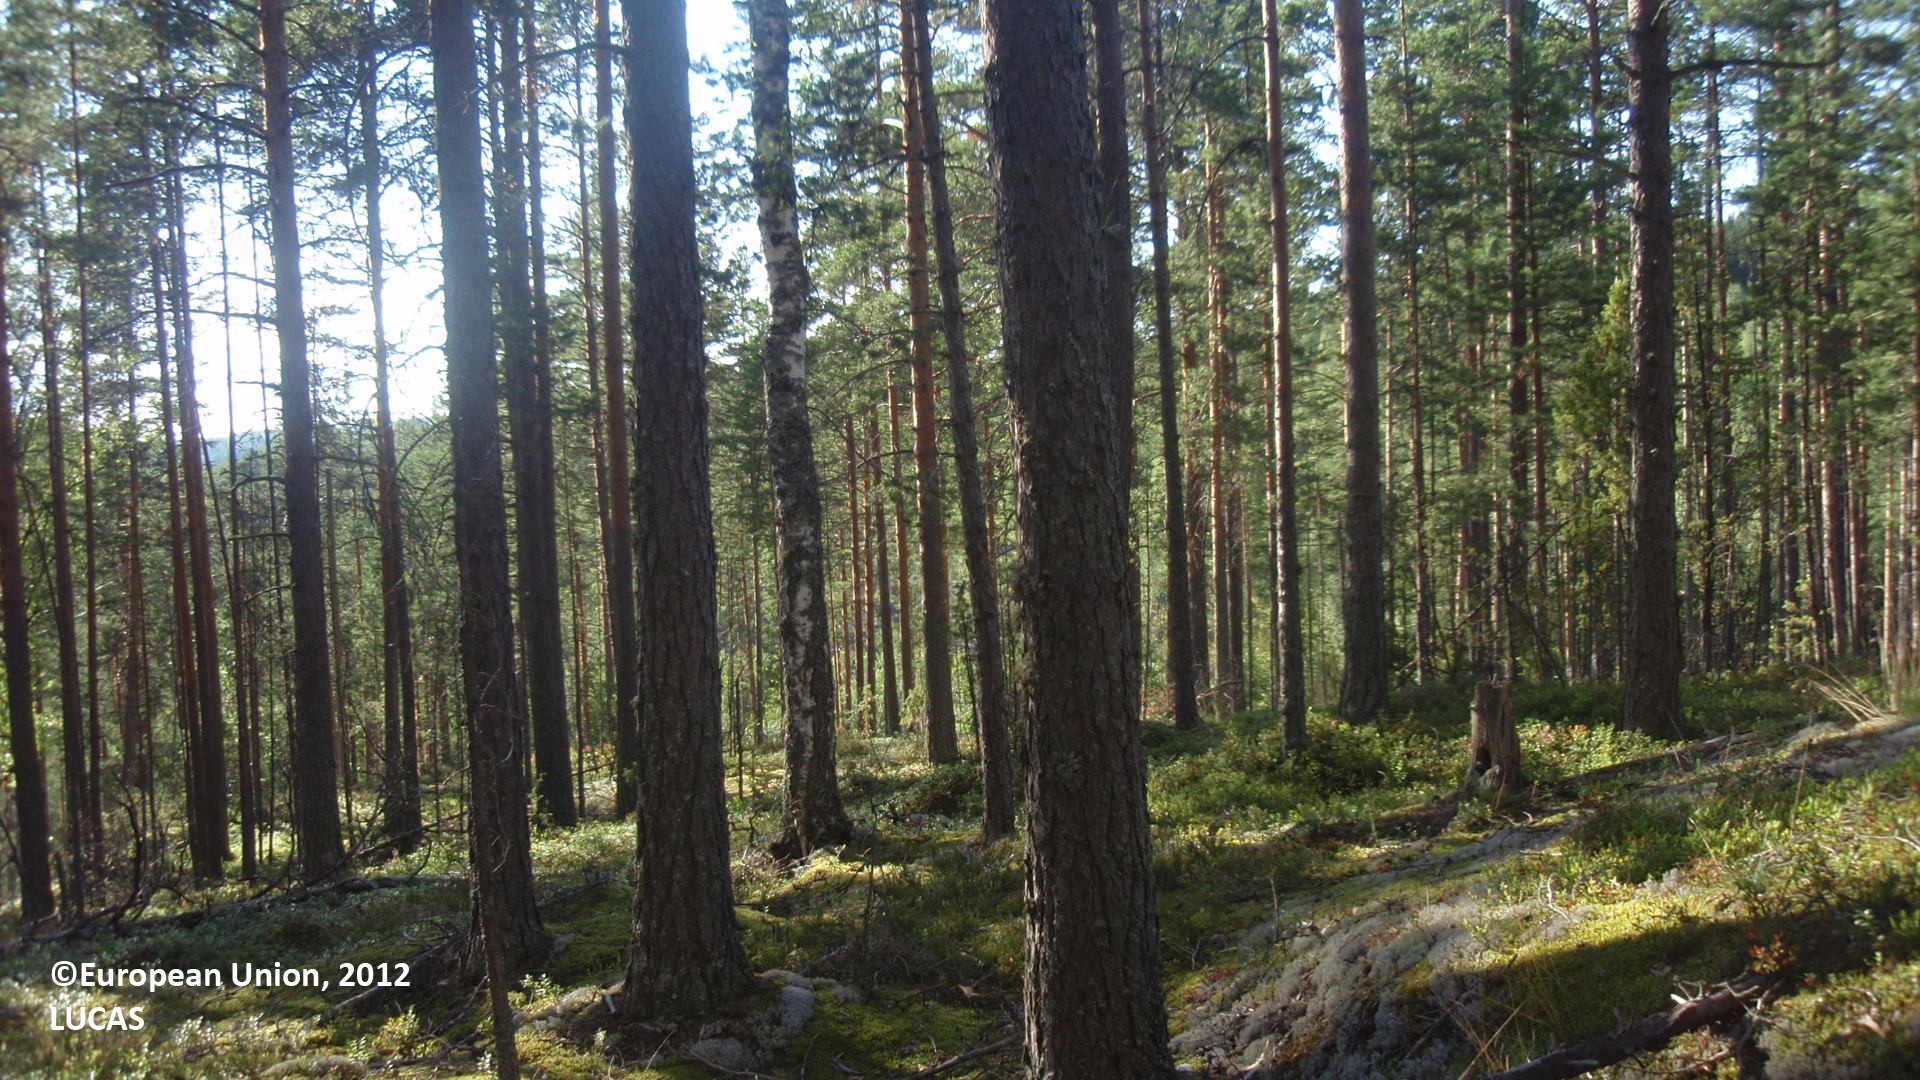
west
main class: Woodland
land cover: Pine dominated coniferous woodland
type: boreal forest
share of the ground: 50 - 75 %
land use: Forestry
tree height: > 5 m
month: August
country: FI
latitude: 61.5578
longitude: 27.7846
